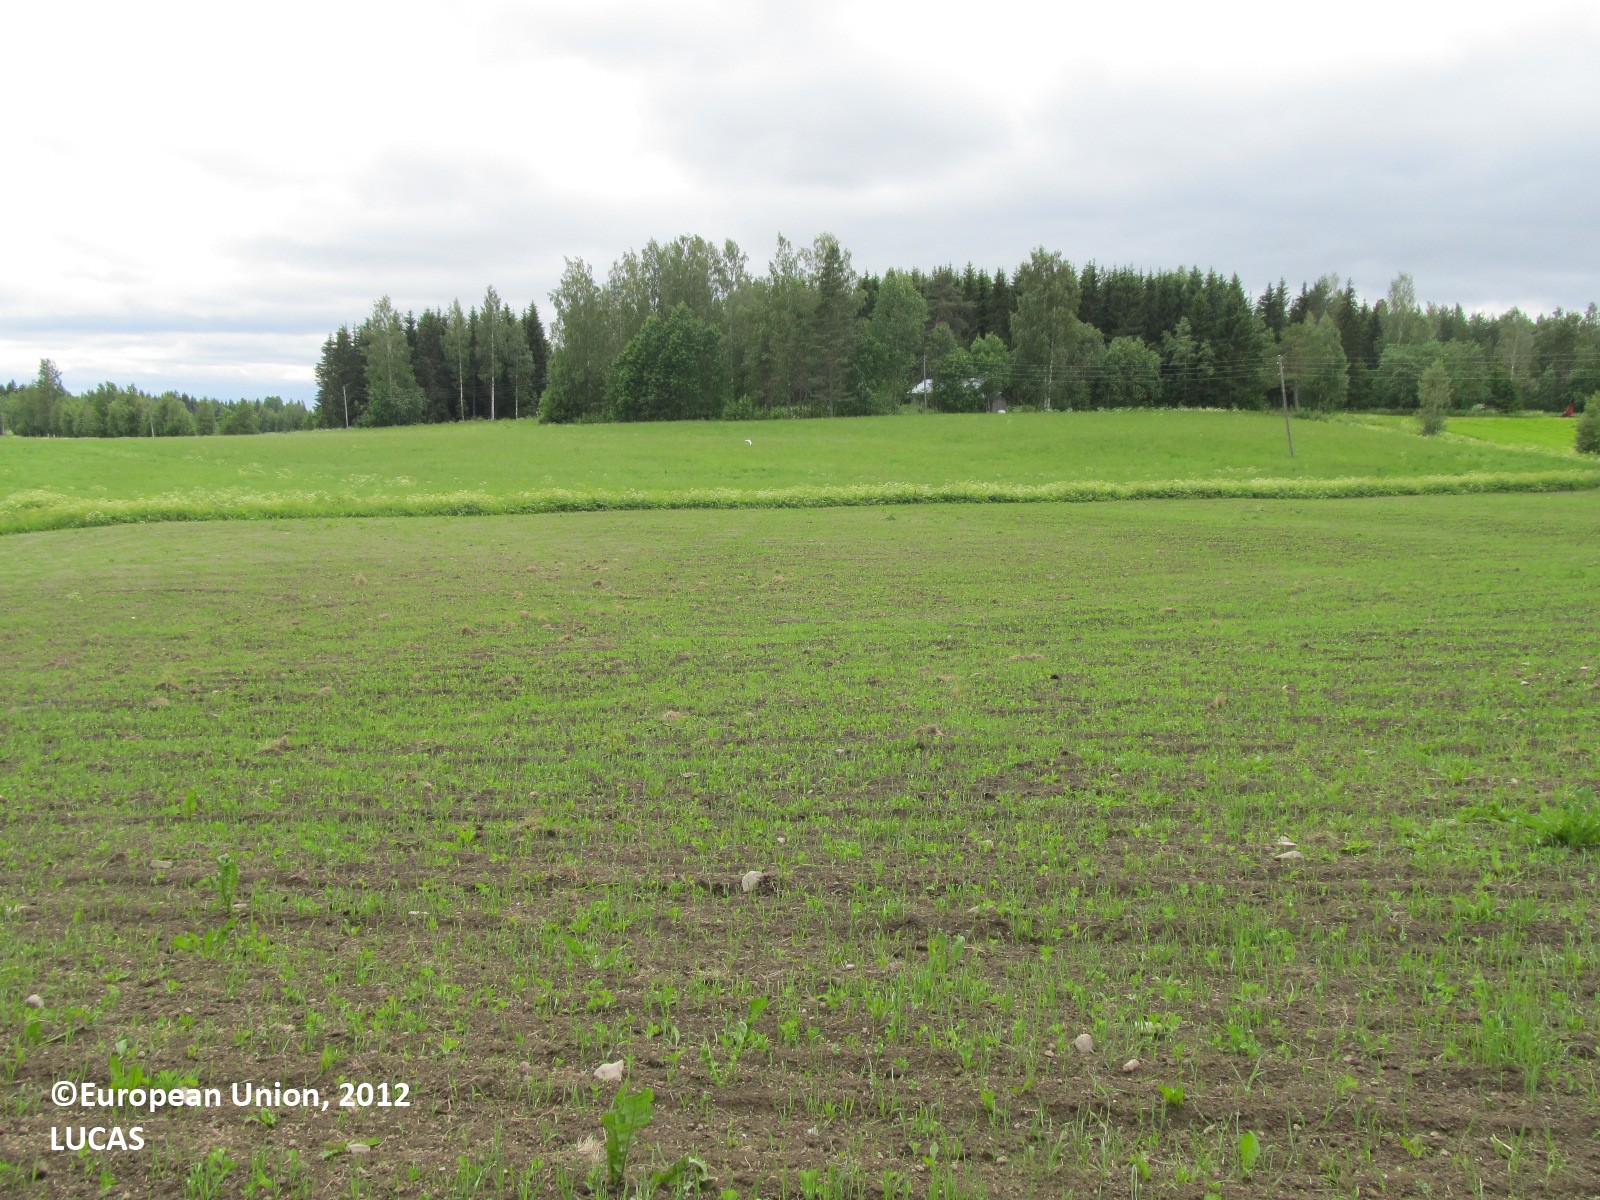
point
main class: Cropland
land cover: Oats
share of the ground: 10 - 25 %
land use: Agriculture (excluding fallow land and kitchen gardens)
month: June
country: FI
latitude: 62.7500
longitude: 29.1126
